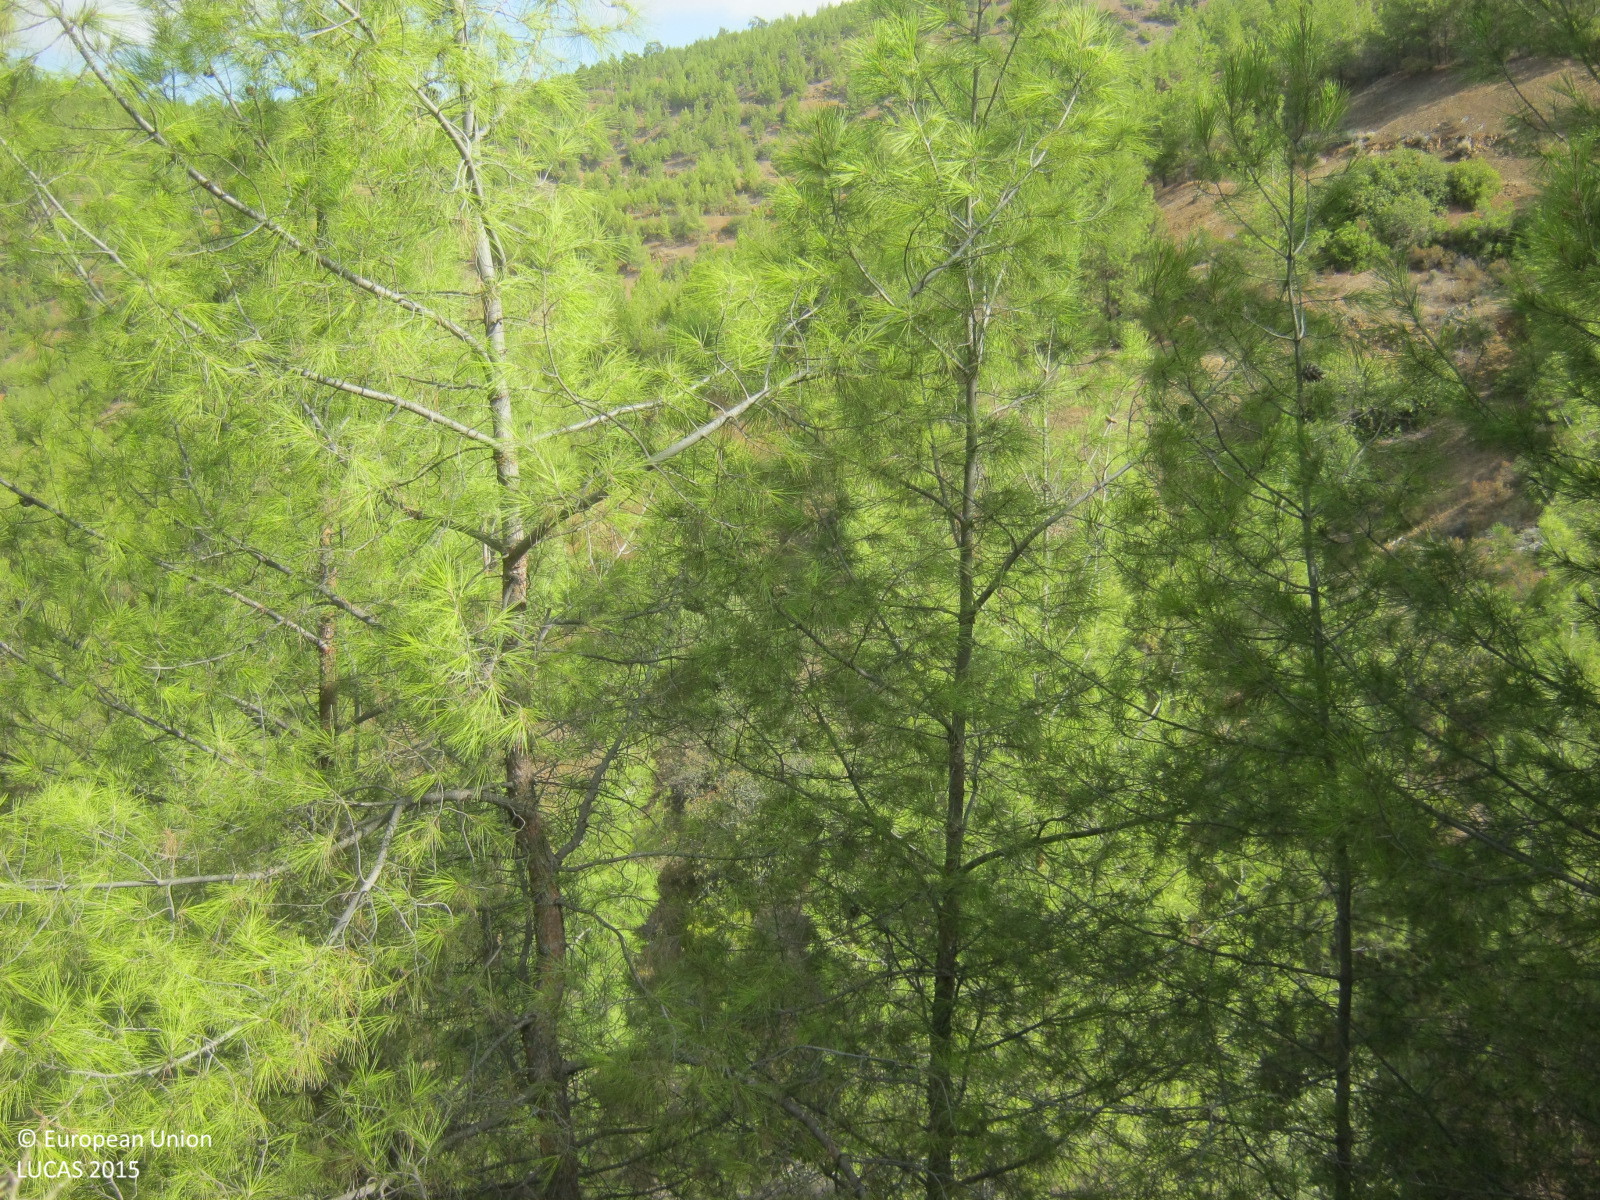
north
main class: Woodland
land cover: Pine dominated coniferous woodland
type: coniferous forest of the mediterranean region
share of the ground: > 75 %
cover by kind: coniferous forest trees 75 %, shrubs 15 %, herbaceous plants 5 %, unconsolidated bare surface 5 %
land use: Forestry
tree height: > 5 m
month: September
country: CY
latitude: 35.0492
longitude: 32.8073
